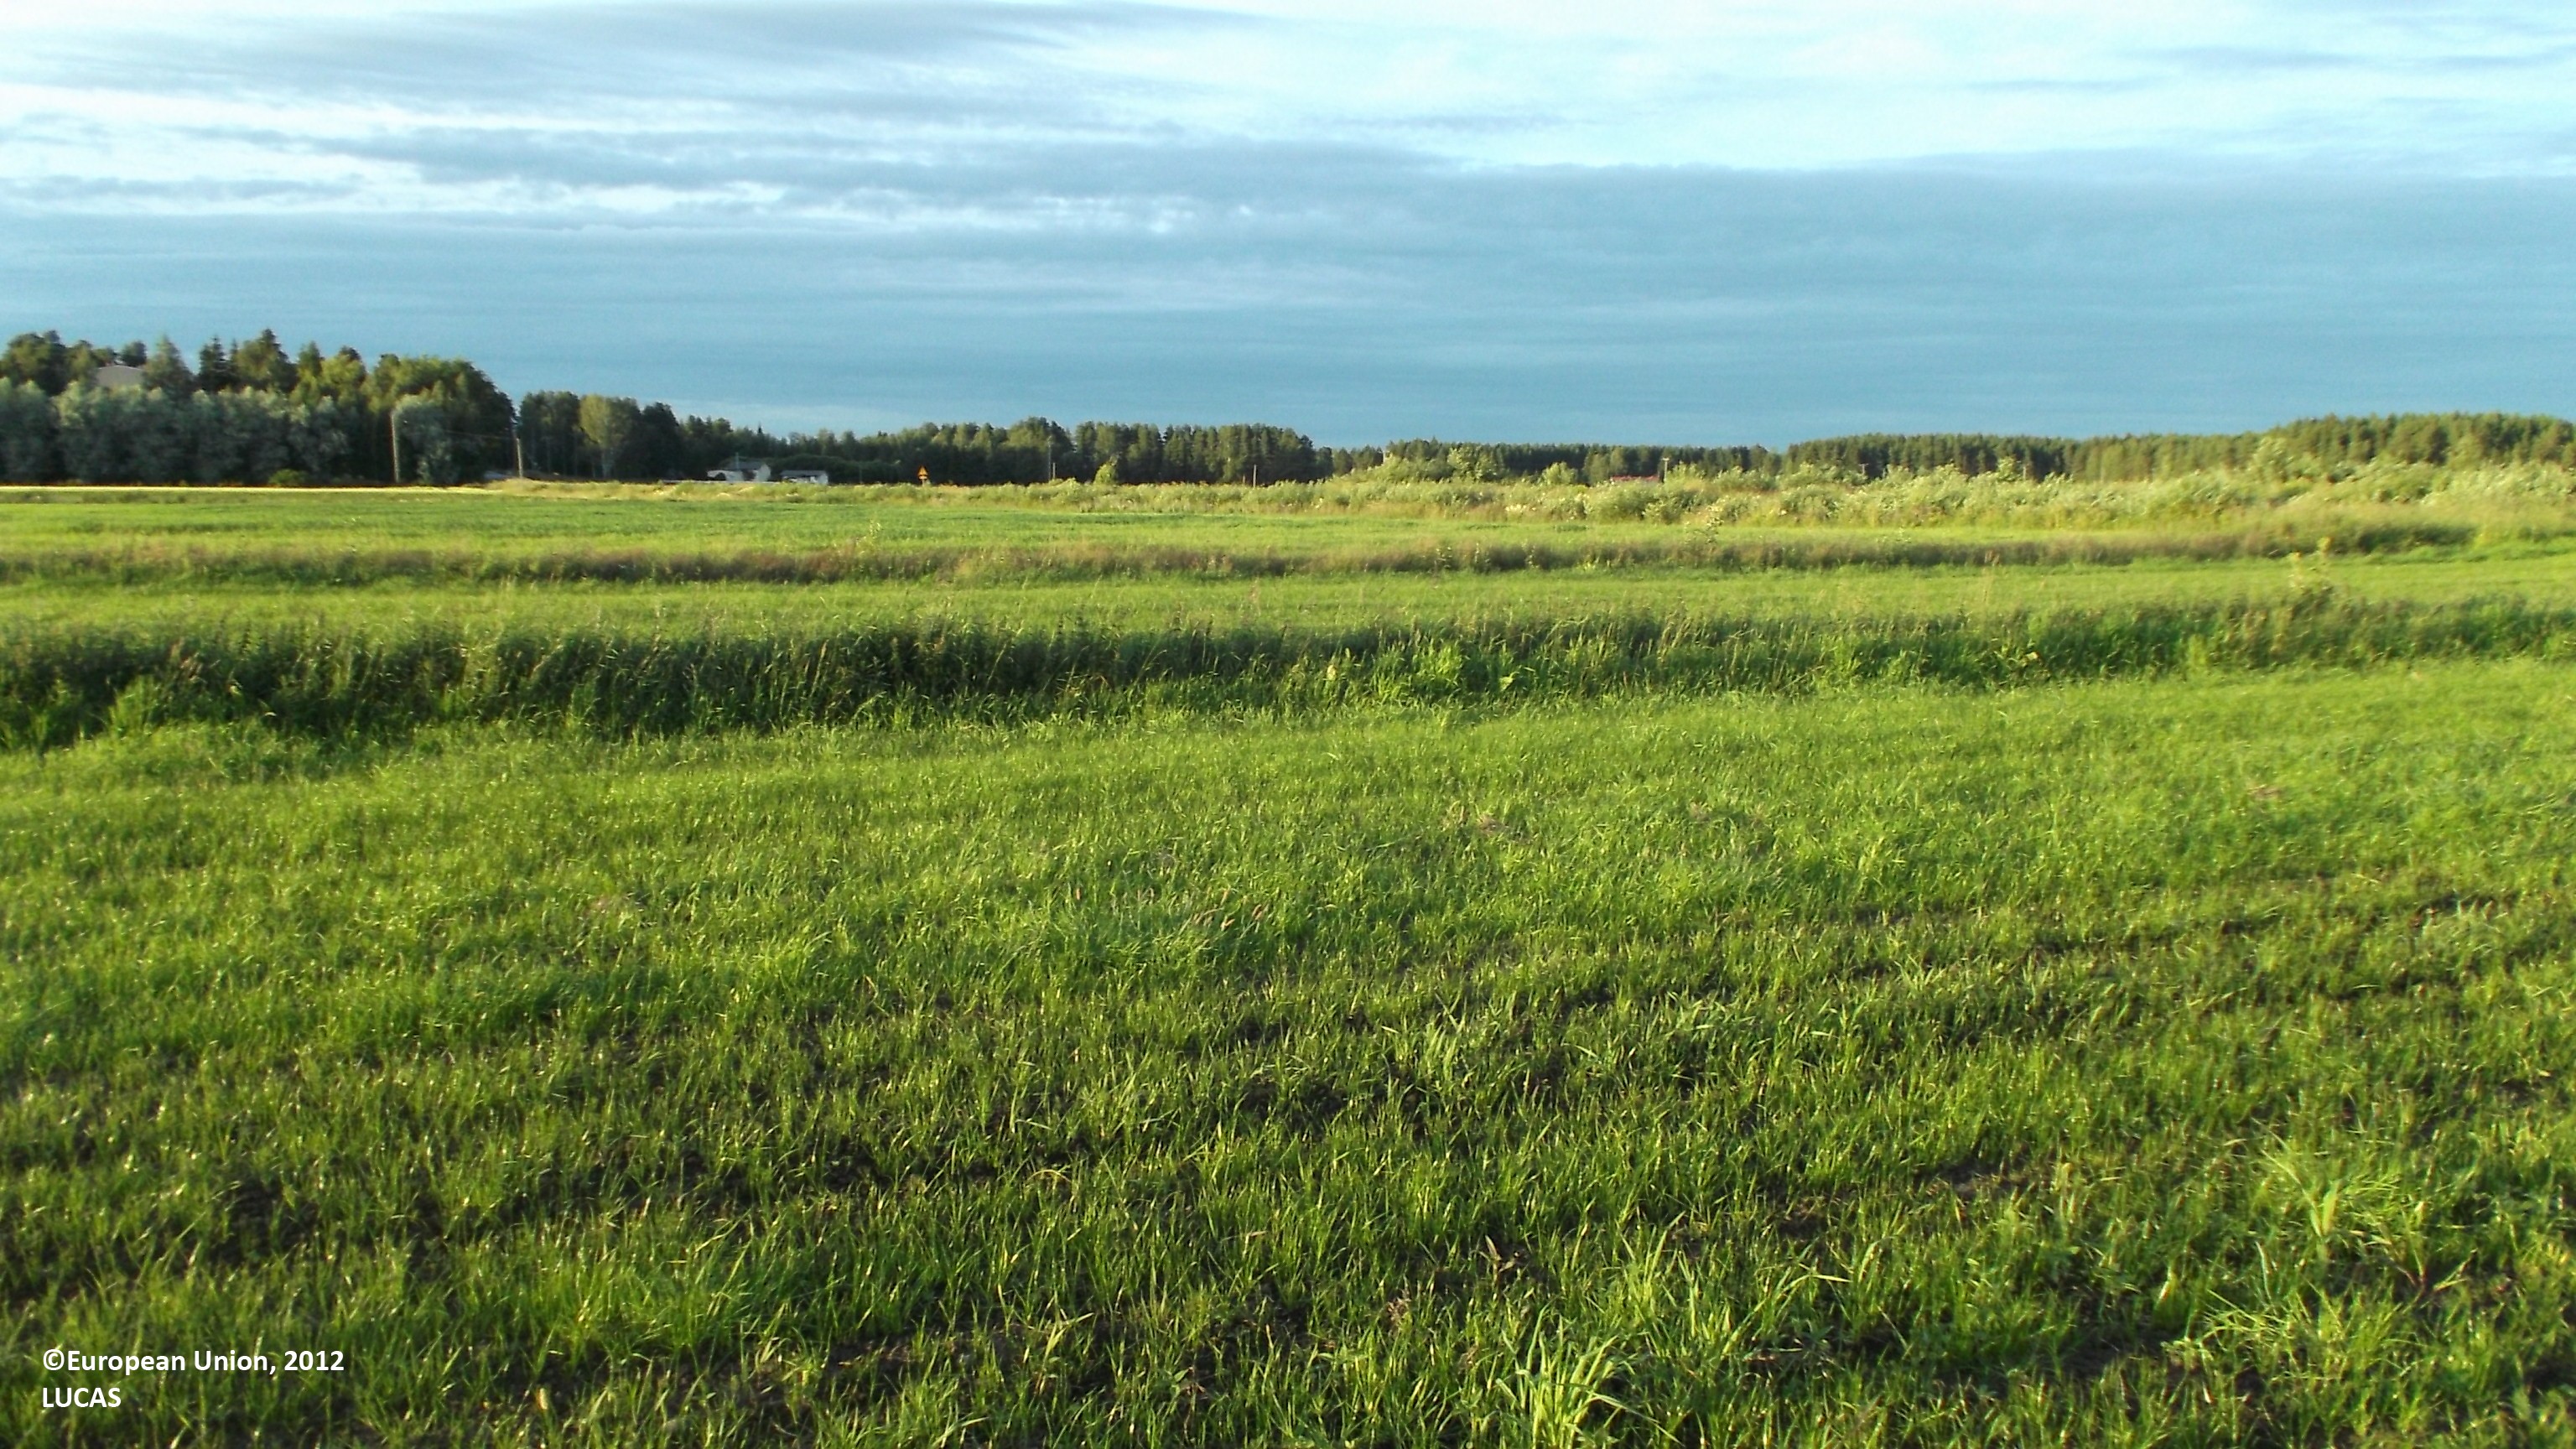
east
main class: Cropland
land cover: Temporary grasslands
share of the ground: 25 - 50 %
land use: Agriculture (excluding fallow land and kitchen gardens)
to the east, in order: Temporary grasslands; Ditches and canals; Temporary grasslands; Ditches and canals; Oats; Abandoned hedges; Ditches and canals; Spontaneously vegetated surfaces; Paved roads, cycling and walking lanes; Grassland without tree/shrub cover; Abandoned hedges; Ditches and canals; Spontaneously vegetated surfaces; Potatoes; Grass margins; Ditches and canals; Grass margins; Common wheat; Grass margins; Abandoned hedges; Ditches and canals; Grass margins; Barley; Grass margins; Ditches and canals; Grassland without tree/shrub cover; Potatoes
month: July
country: FI
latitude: 63.1462
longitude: 23.8219
